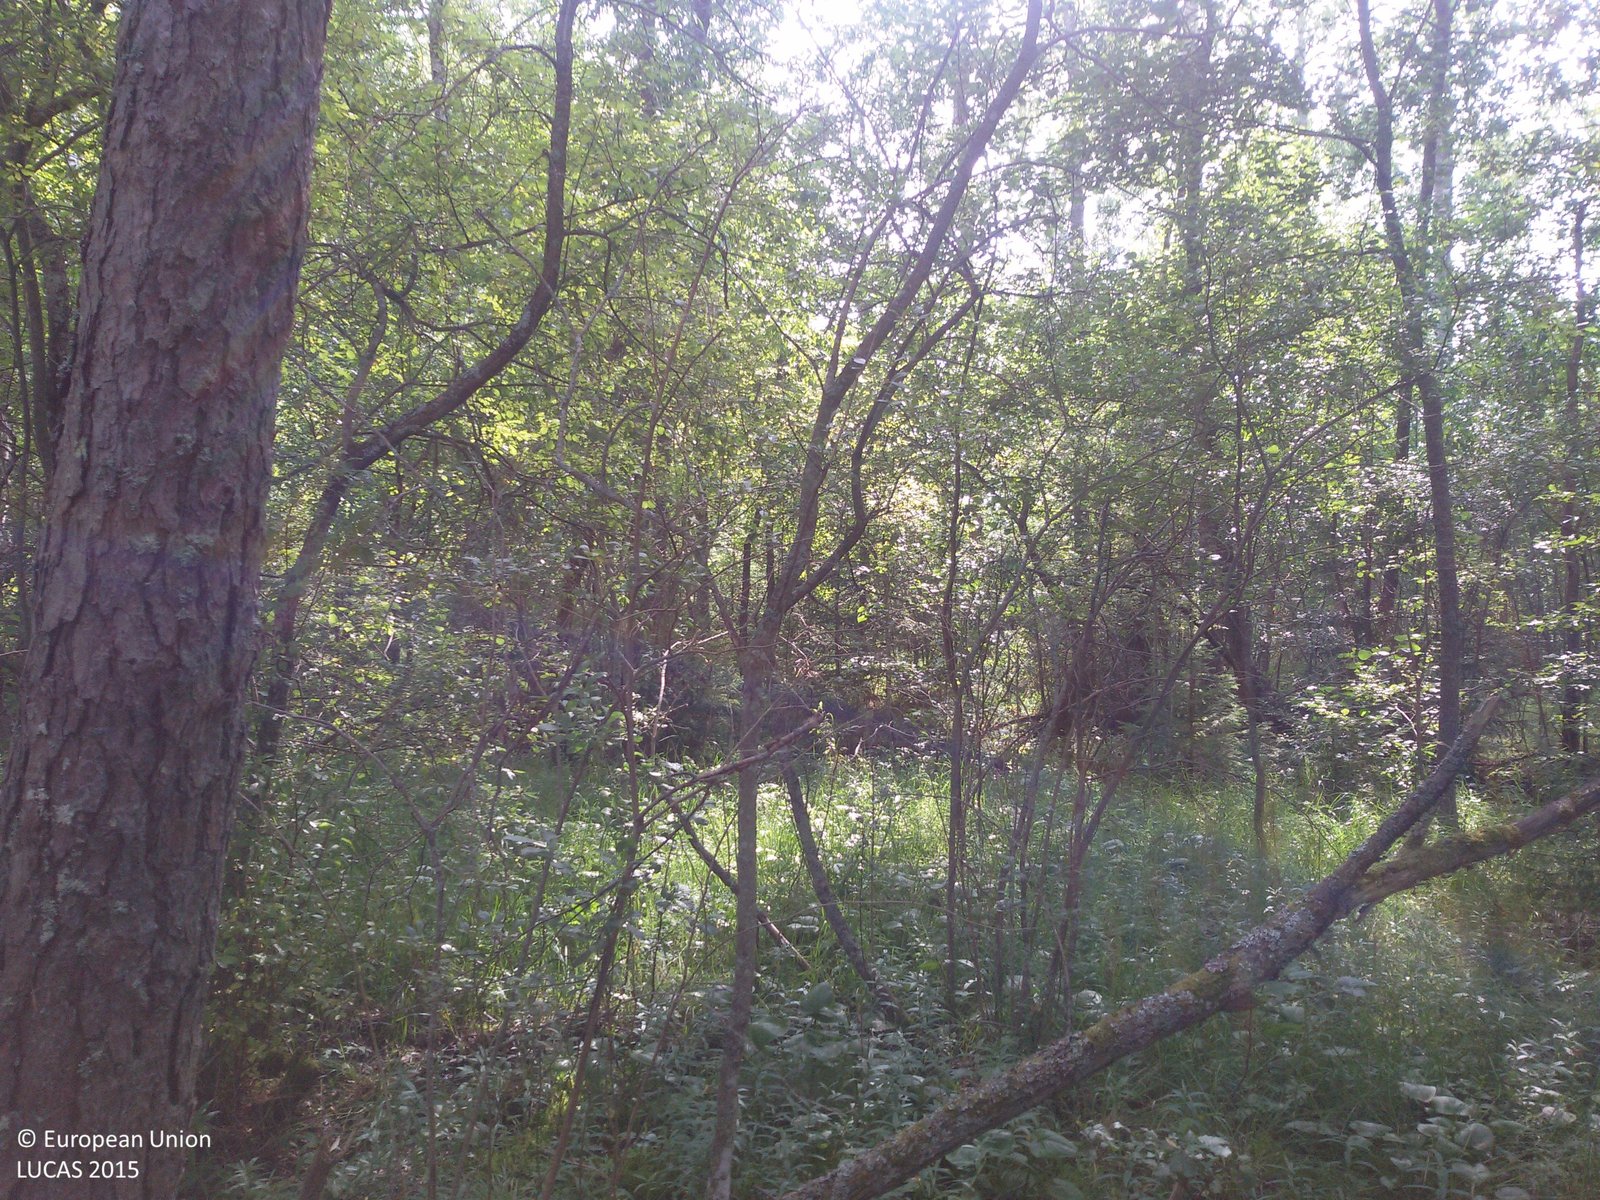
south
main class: Woodland
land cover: Pine dominated mixed woodland
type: hemiboreal forest and nemoral coniferous forest and mixed broadleaved-coniferous forest
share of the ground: > 75 %
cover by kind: broadleaved forest trees 60 %, coniferous forest trees 25 %, herbaceous plants 10 %, lichens and mosses 5 %
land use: Semi-natural and natural areas not in use
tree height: > 5 m
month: August
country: SE
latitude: 60.4767
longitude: 16.6291
